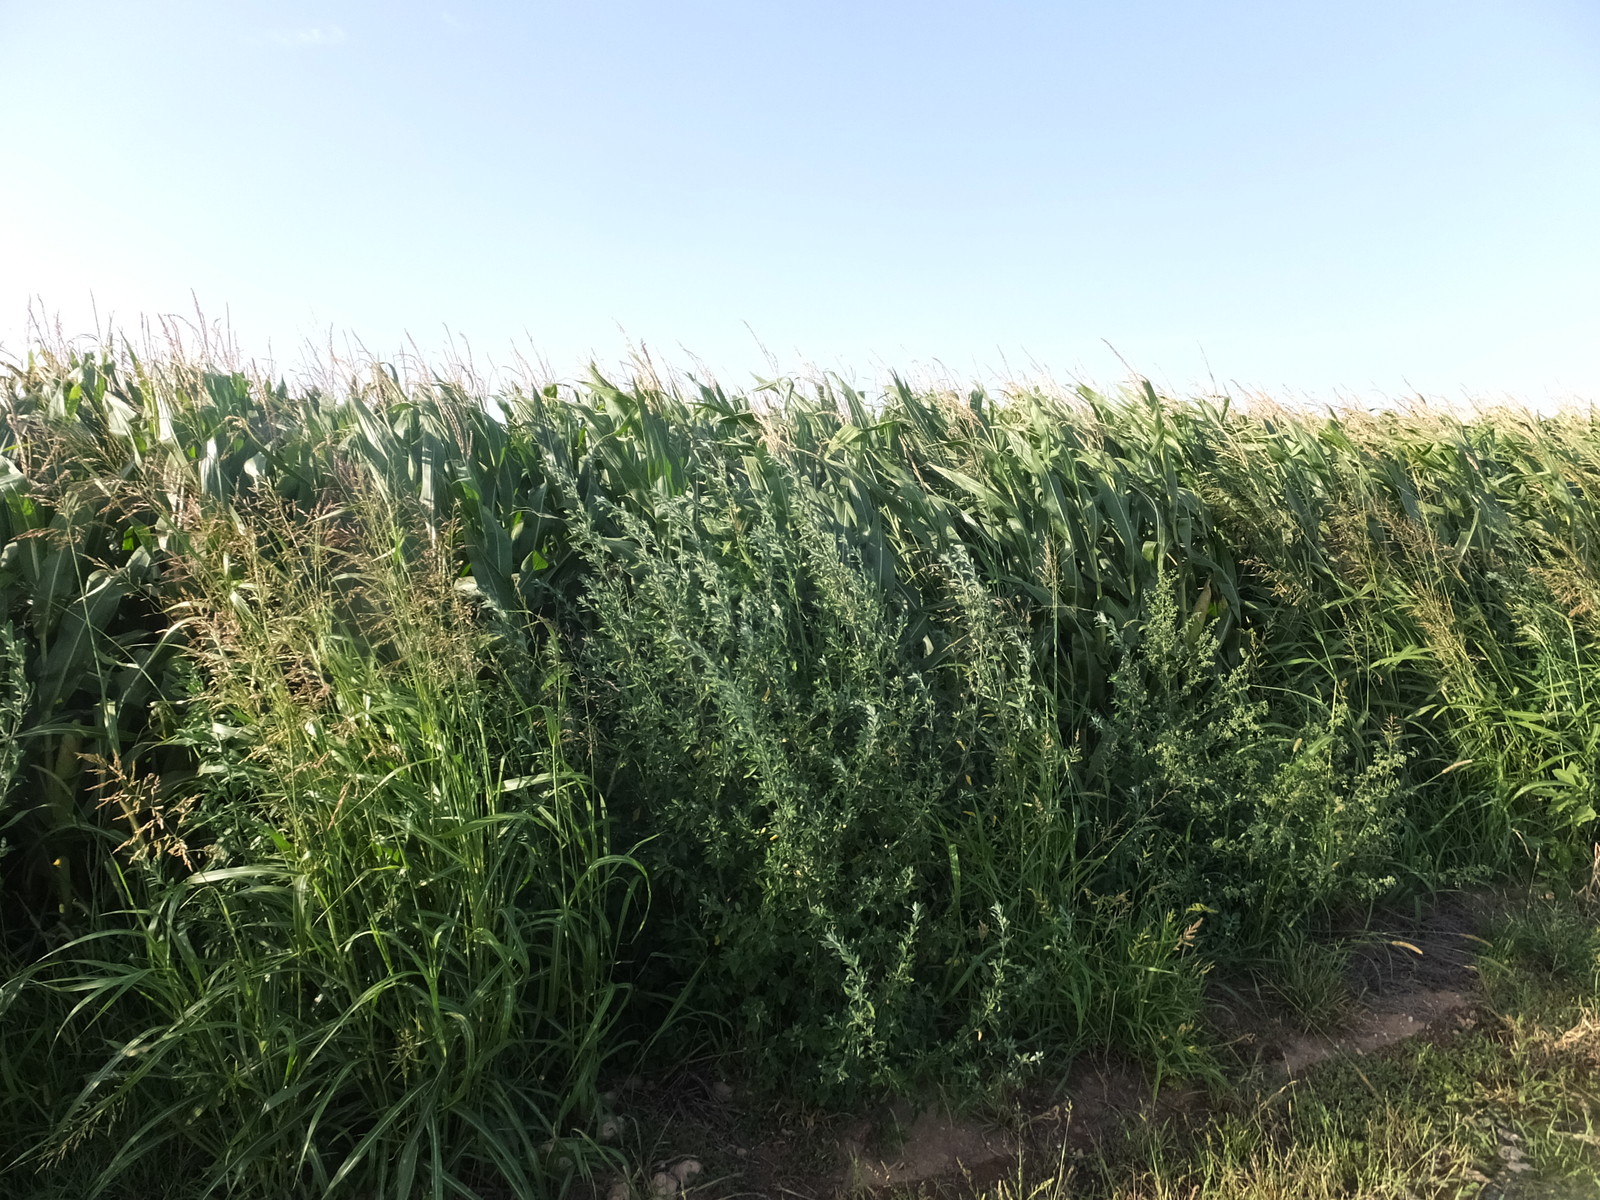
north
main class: Cropland
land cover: Common wheat
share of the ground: < 10 %
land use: Agriculture (excluding fallow land and kitchen gardens)
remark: Harvested field
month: August
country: ES
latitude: 41.6307
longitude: 0.3714
